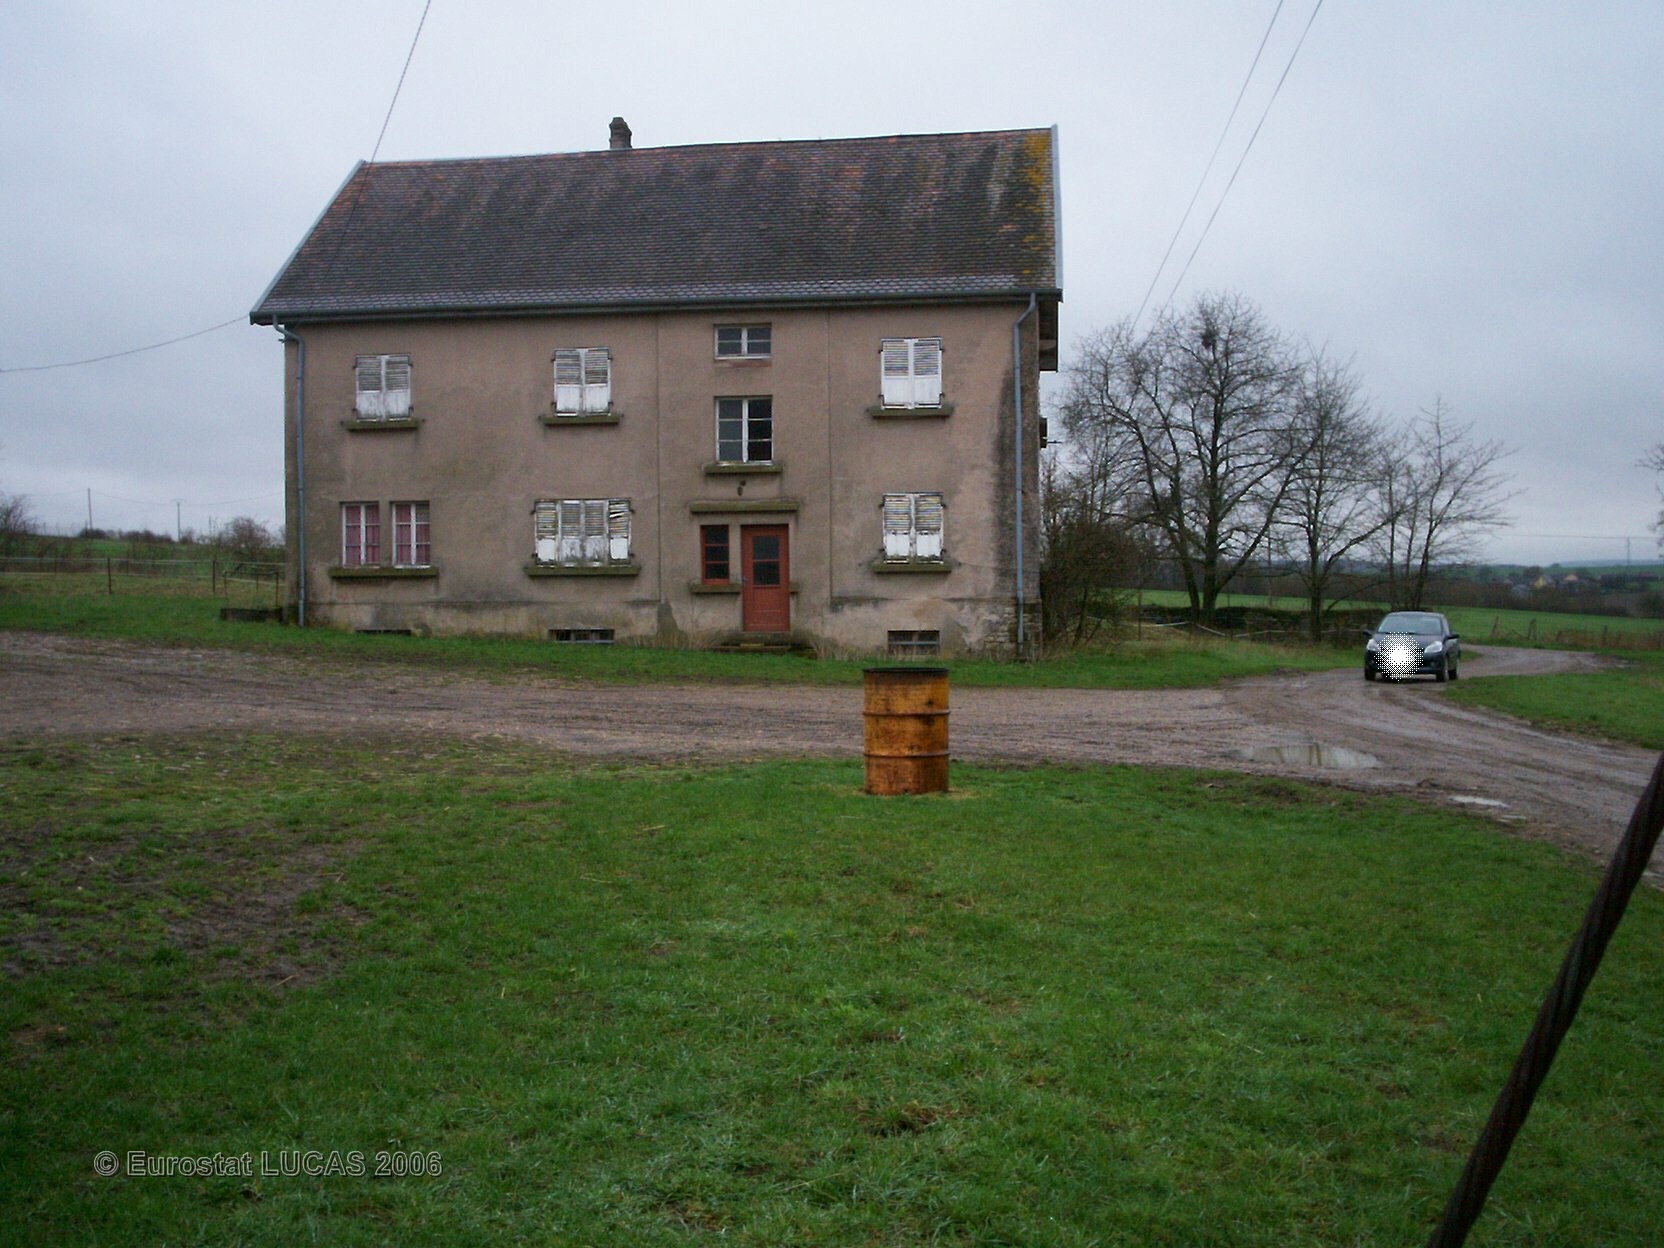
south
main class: Grassland
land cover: Grassland without tree/shrub cover
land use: Agriculture (excluding fallow land and kitchen gardens)
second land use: Residential
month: April
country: FR
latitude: 48.7228
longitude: 6.9964
